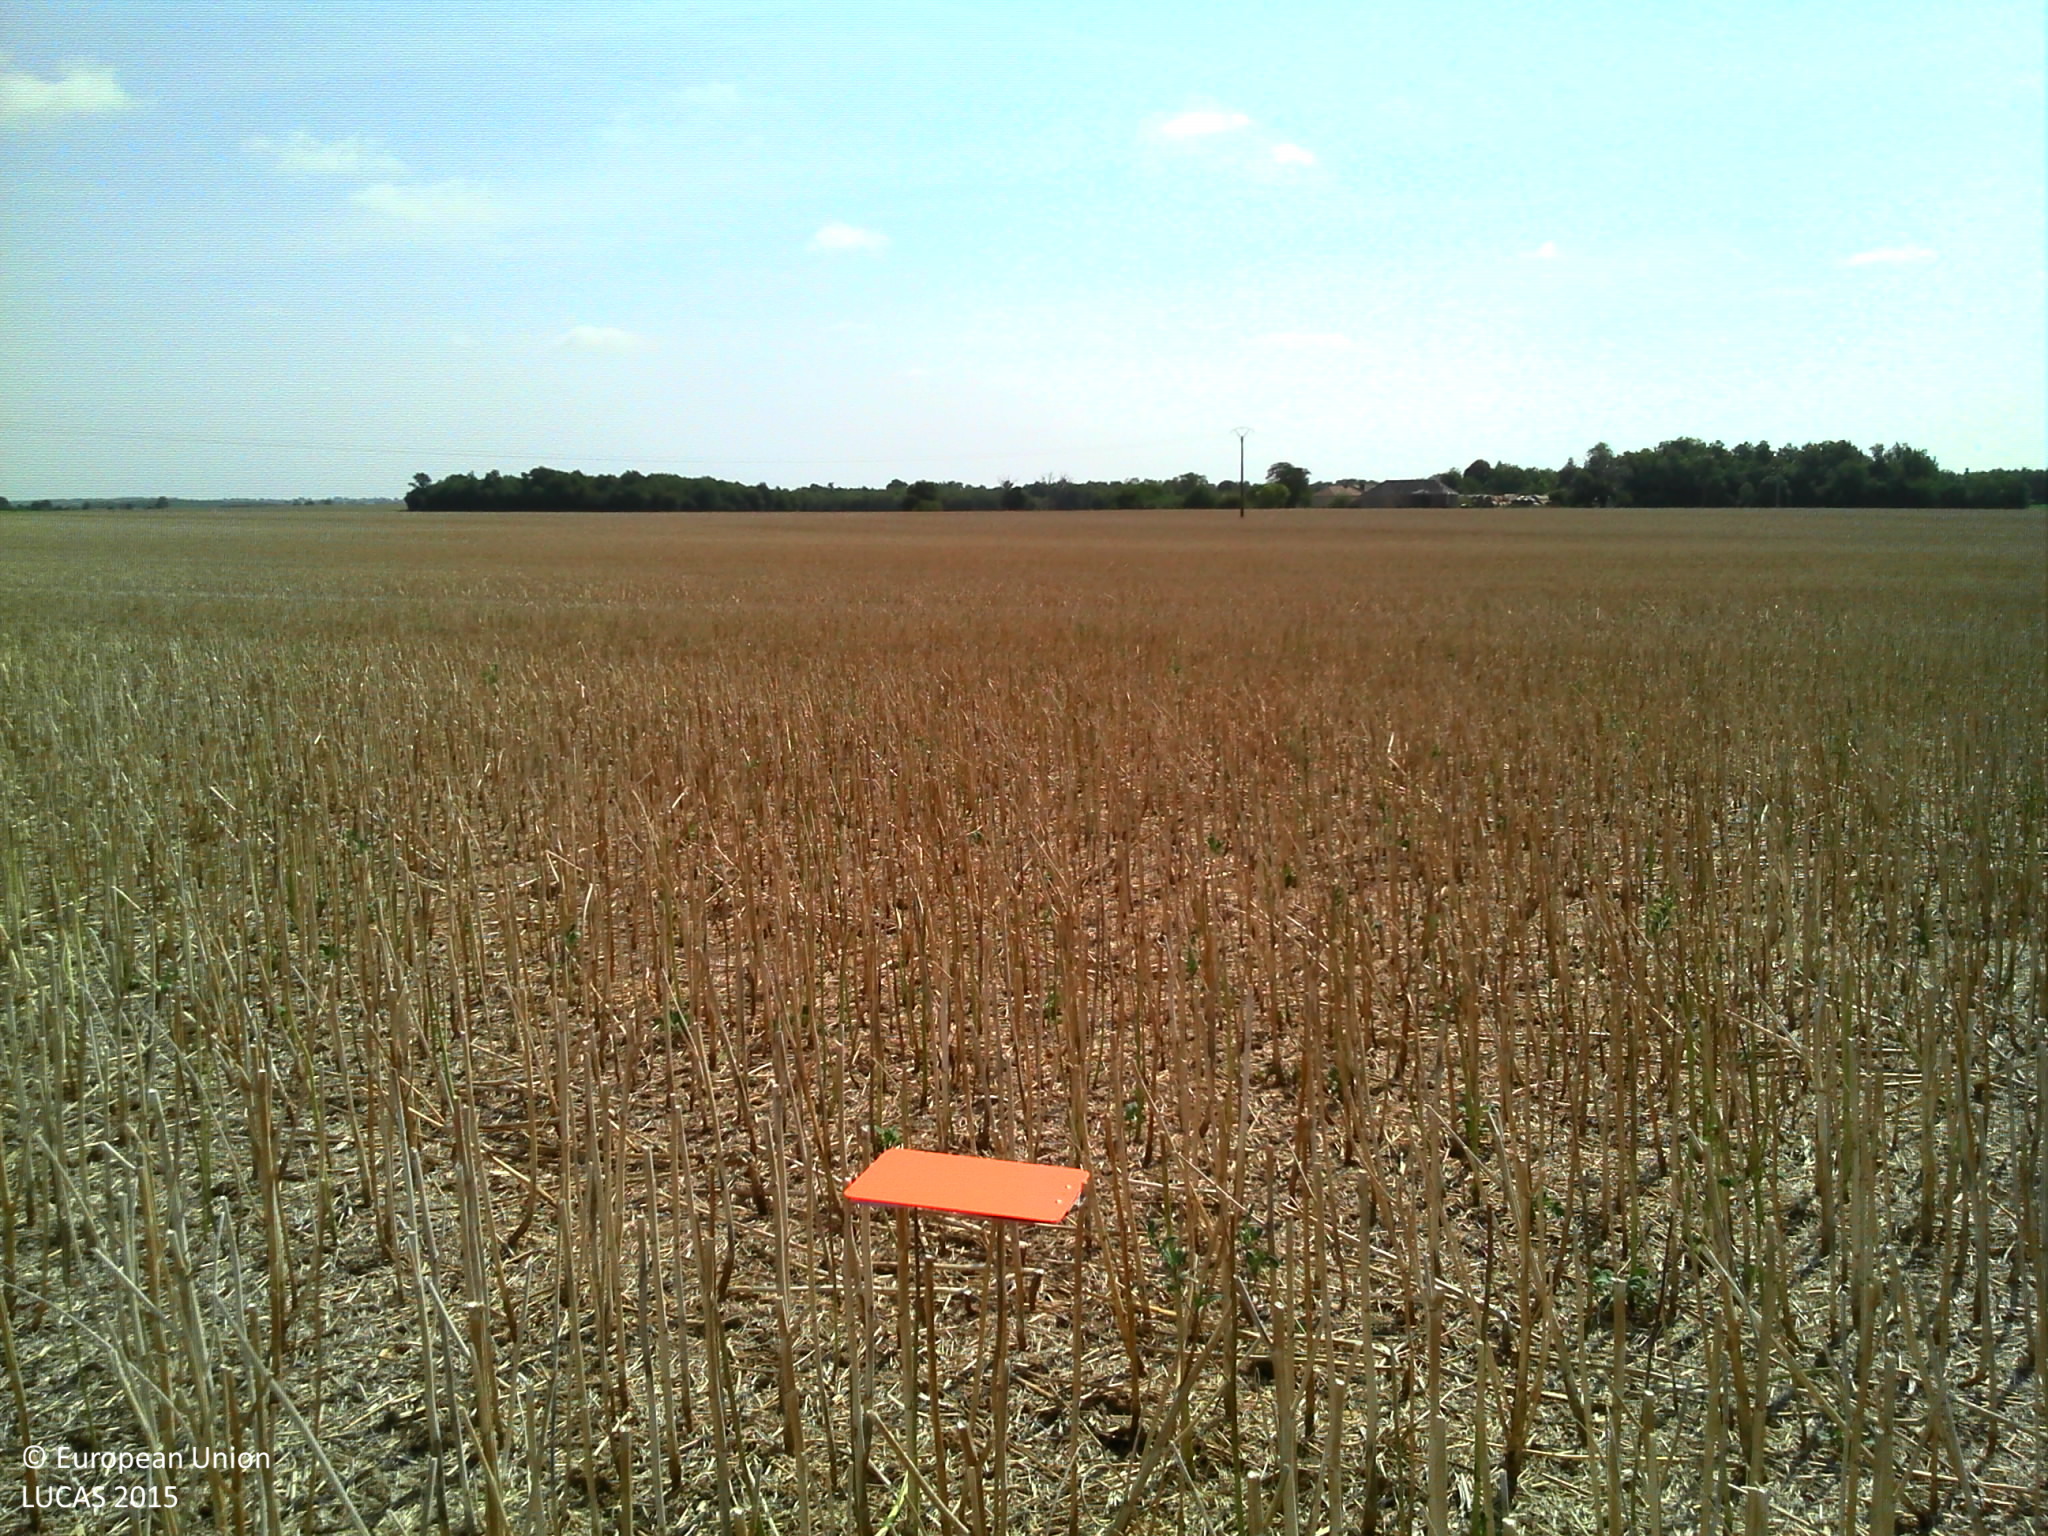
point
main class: Cropland
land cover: Rape and turnip rape
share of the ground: < 10 %
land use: Agriculture (excluding fallow land and kitchen gardens)
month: August
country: FR
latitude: 46.2556
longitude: 0.3178
